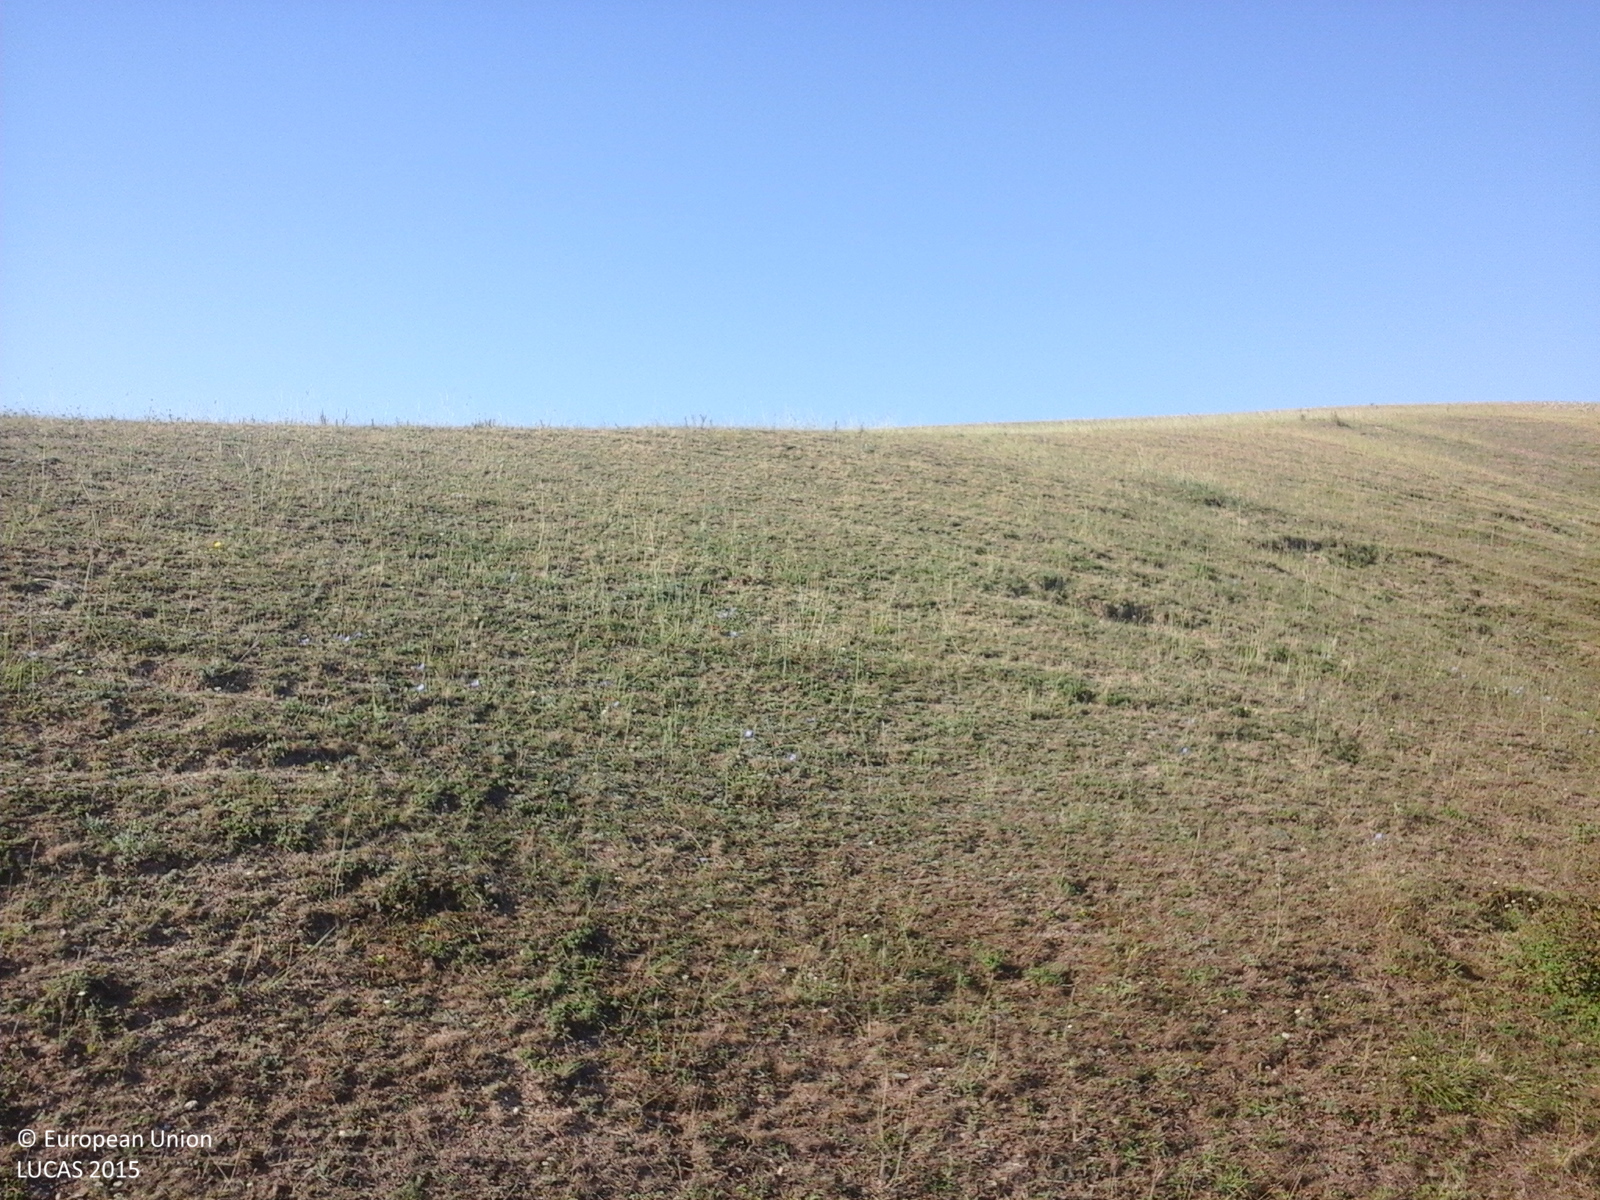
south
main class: Grassland
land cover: Grassland without tree/shrub cover
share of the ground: > 75 %
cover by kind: herbaceous plants 100 %
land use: Agriculture (excluding fallow land and kitchen gardens)
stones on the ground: > 50 %
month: August
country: RO
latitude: 44.4586
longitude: 28.5104
